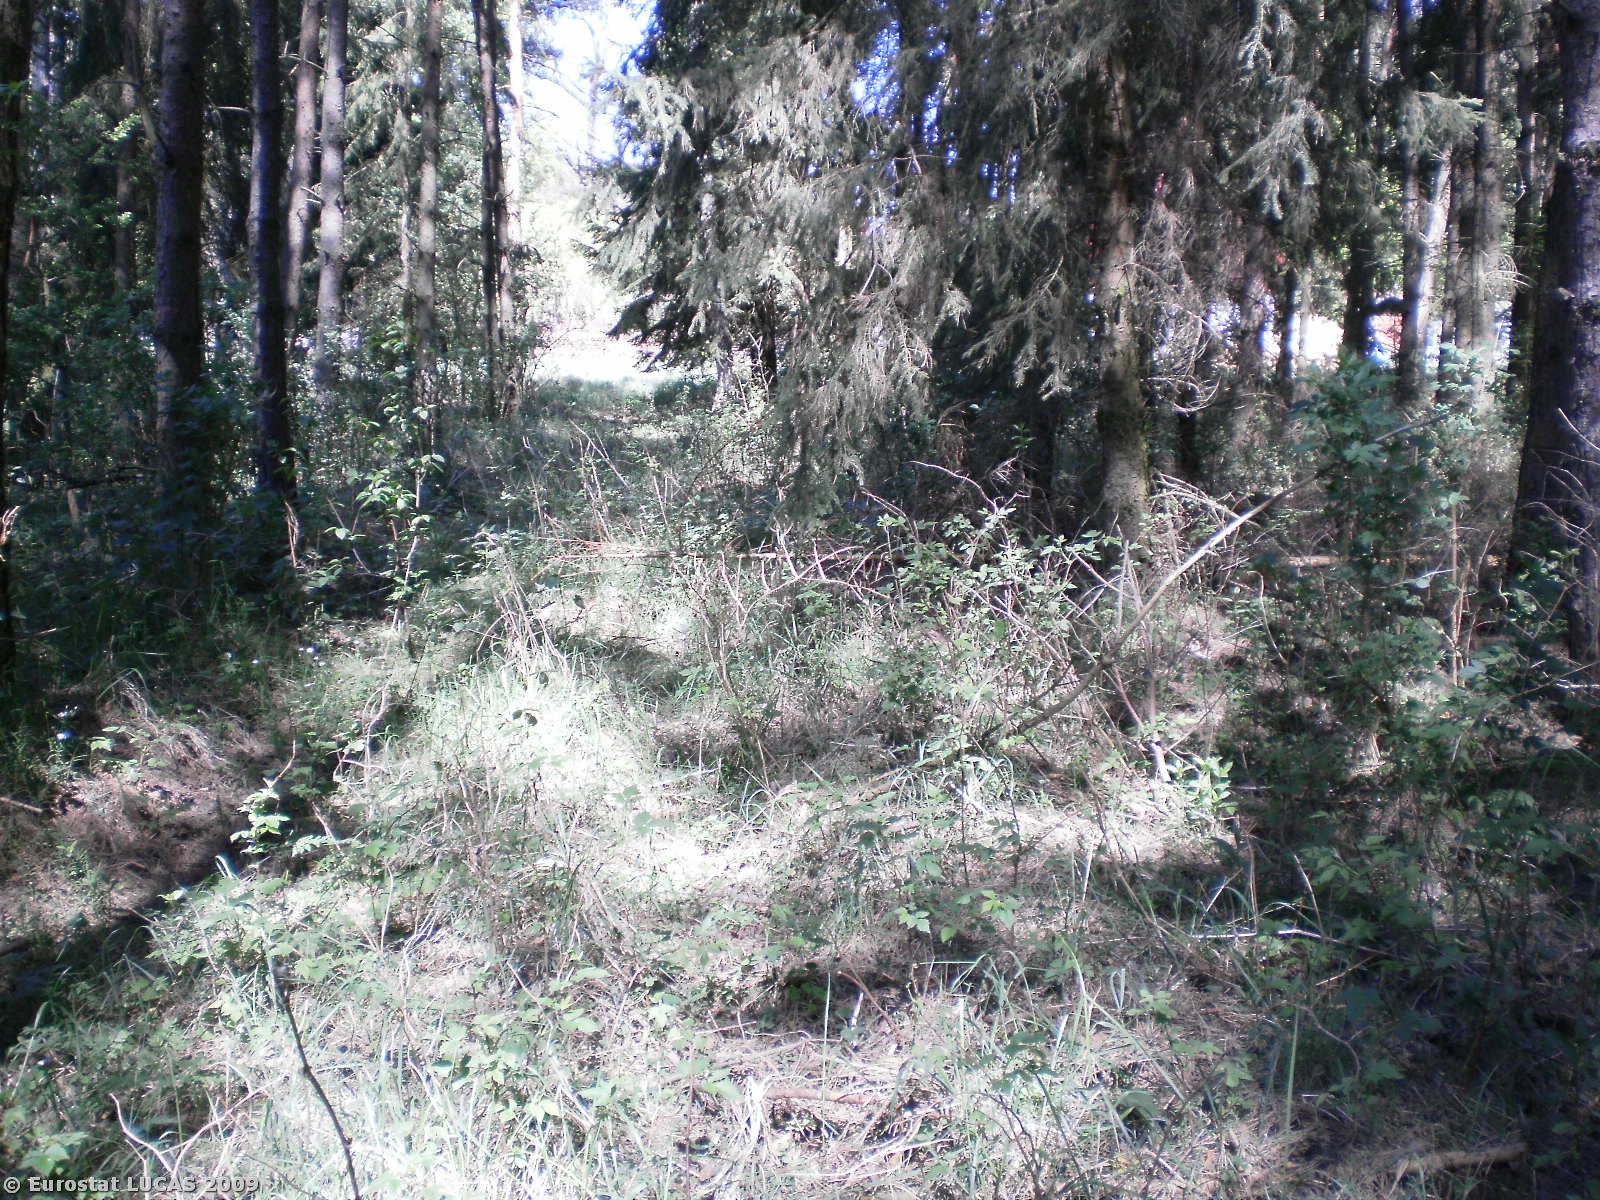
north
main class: Woodland
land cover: Coniferous woodland
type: hemiboreal forest and nemoral coniferous forest and mixed broadleaved-coniferous forest
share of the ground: > 75 %
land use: Forestry
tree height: > 5 m
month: January
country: PL
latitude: 53.9040
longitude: 18.9252
